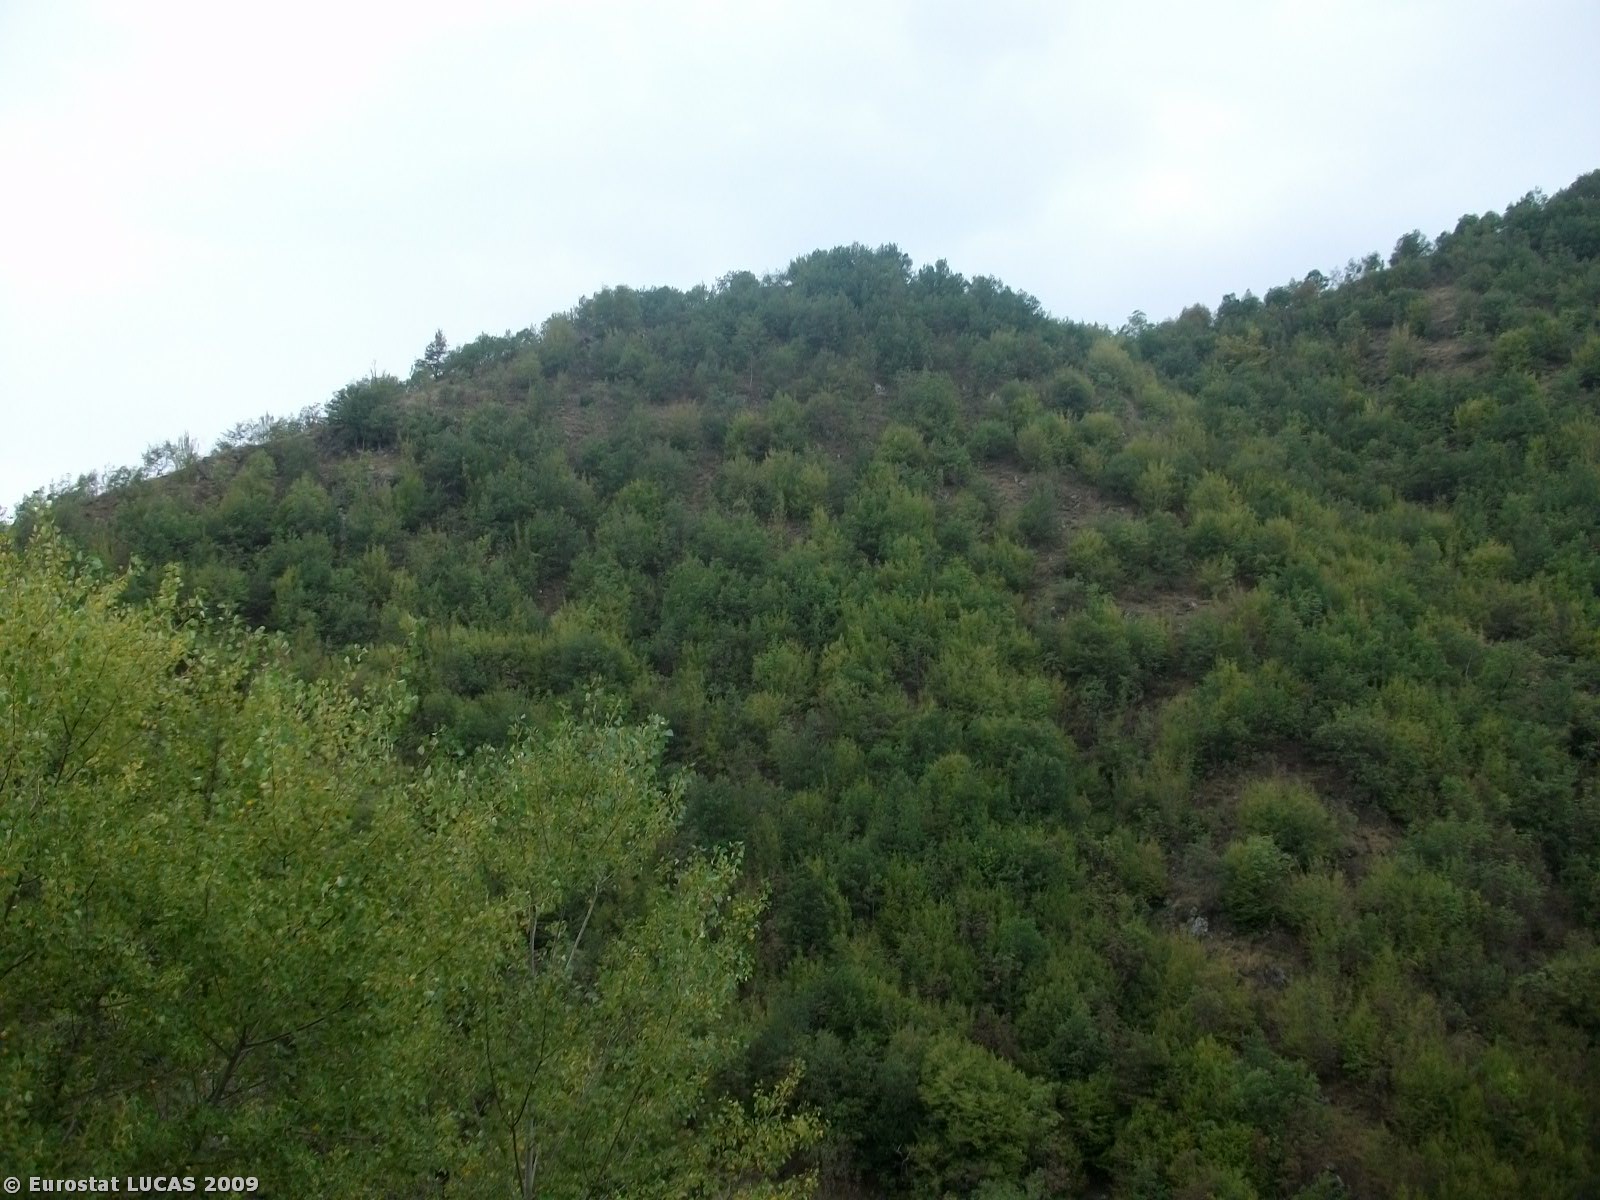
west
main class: Woodland
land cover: Broadleaved woodland
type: broadleaved evergreen forest
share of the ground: > 75 %
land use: Forestry
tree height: > 5 m
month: September
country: GR
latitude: 41.3634
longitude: 24.3932
